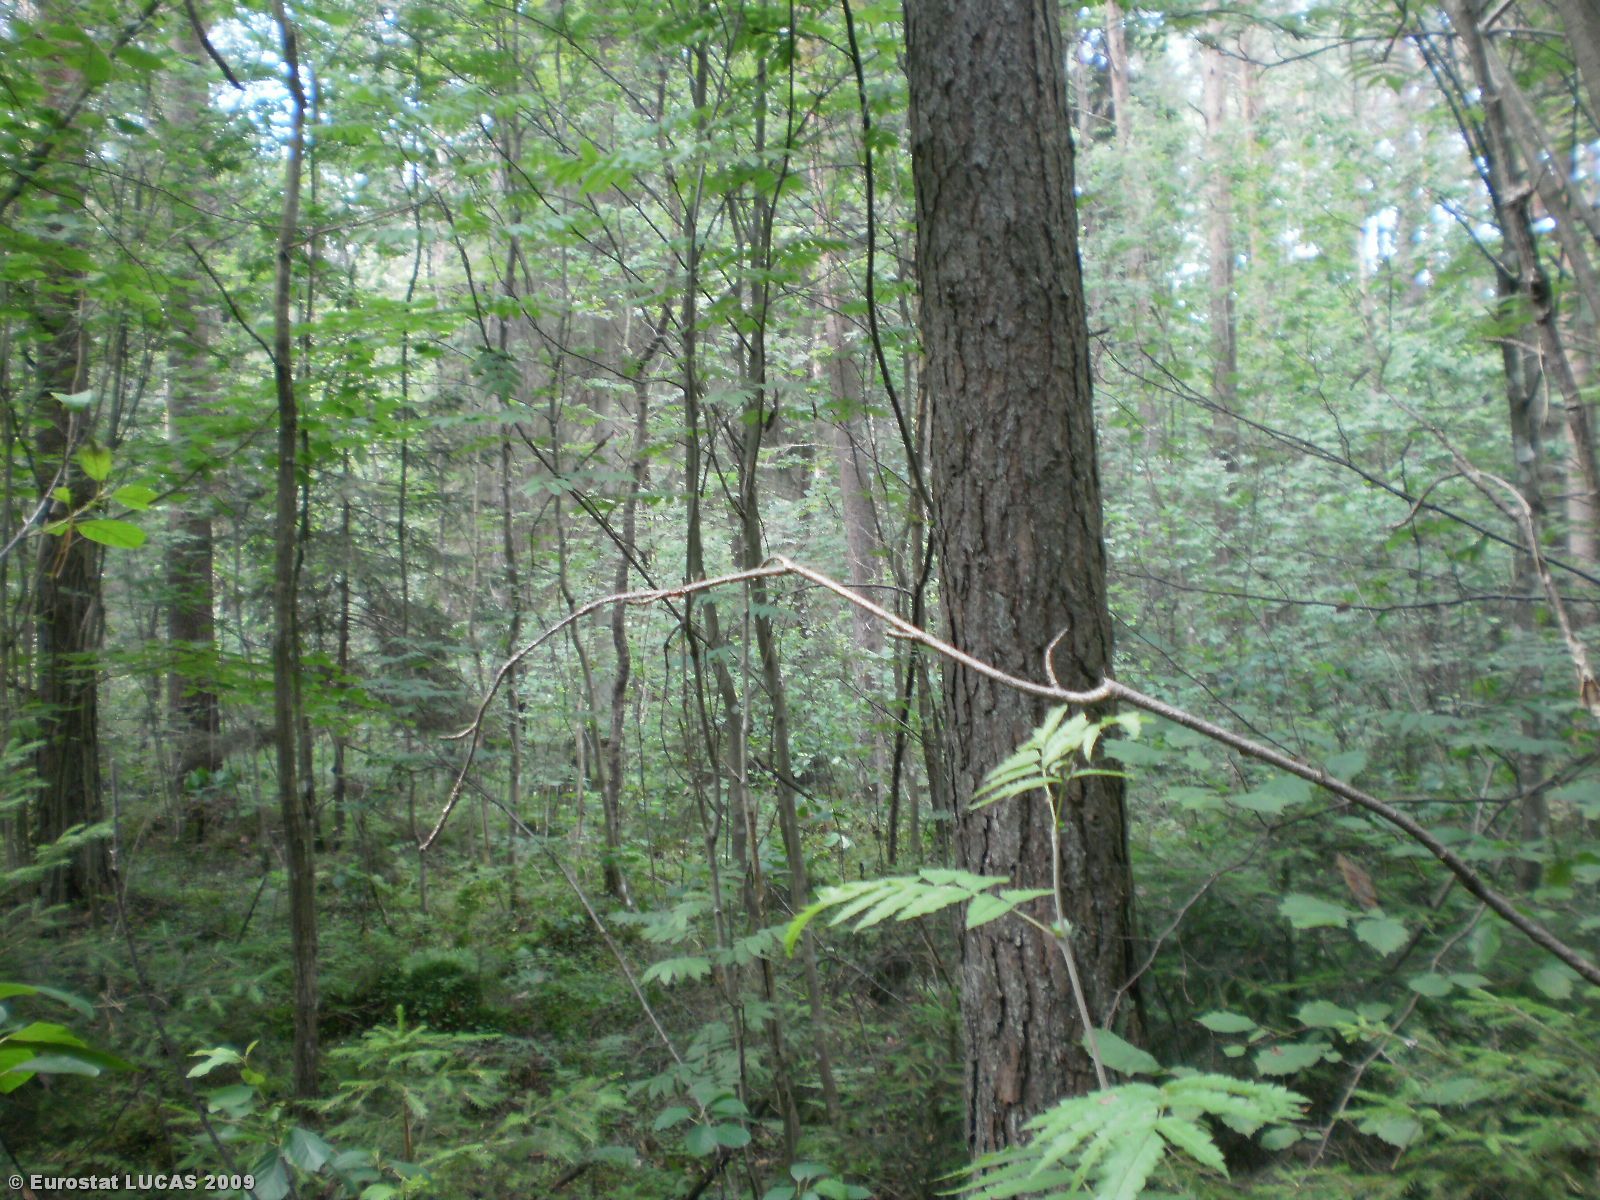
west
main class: Woodland
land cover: Coniferous woodland
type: boreal forest
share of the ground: 25 - 50 %
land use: Forestry
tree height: > 5 m
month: July
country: LT
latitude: 56.0110
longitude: 25.1750
